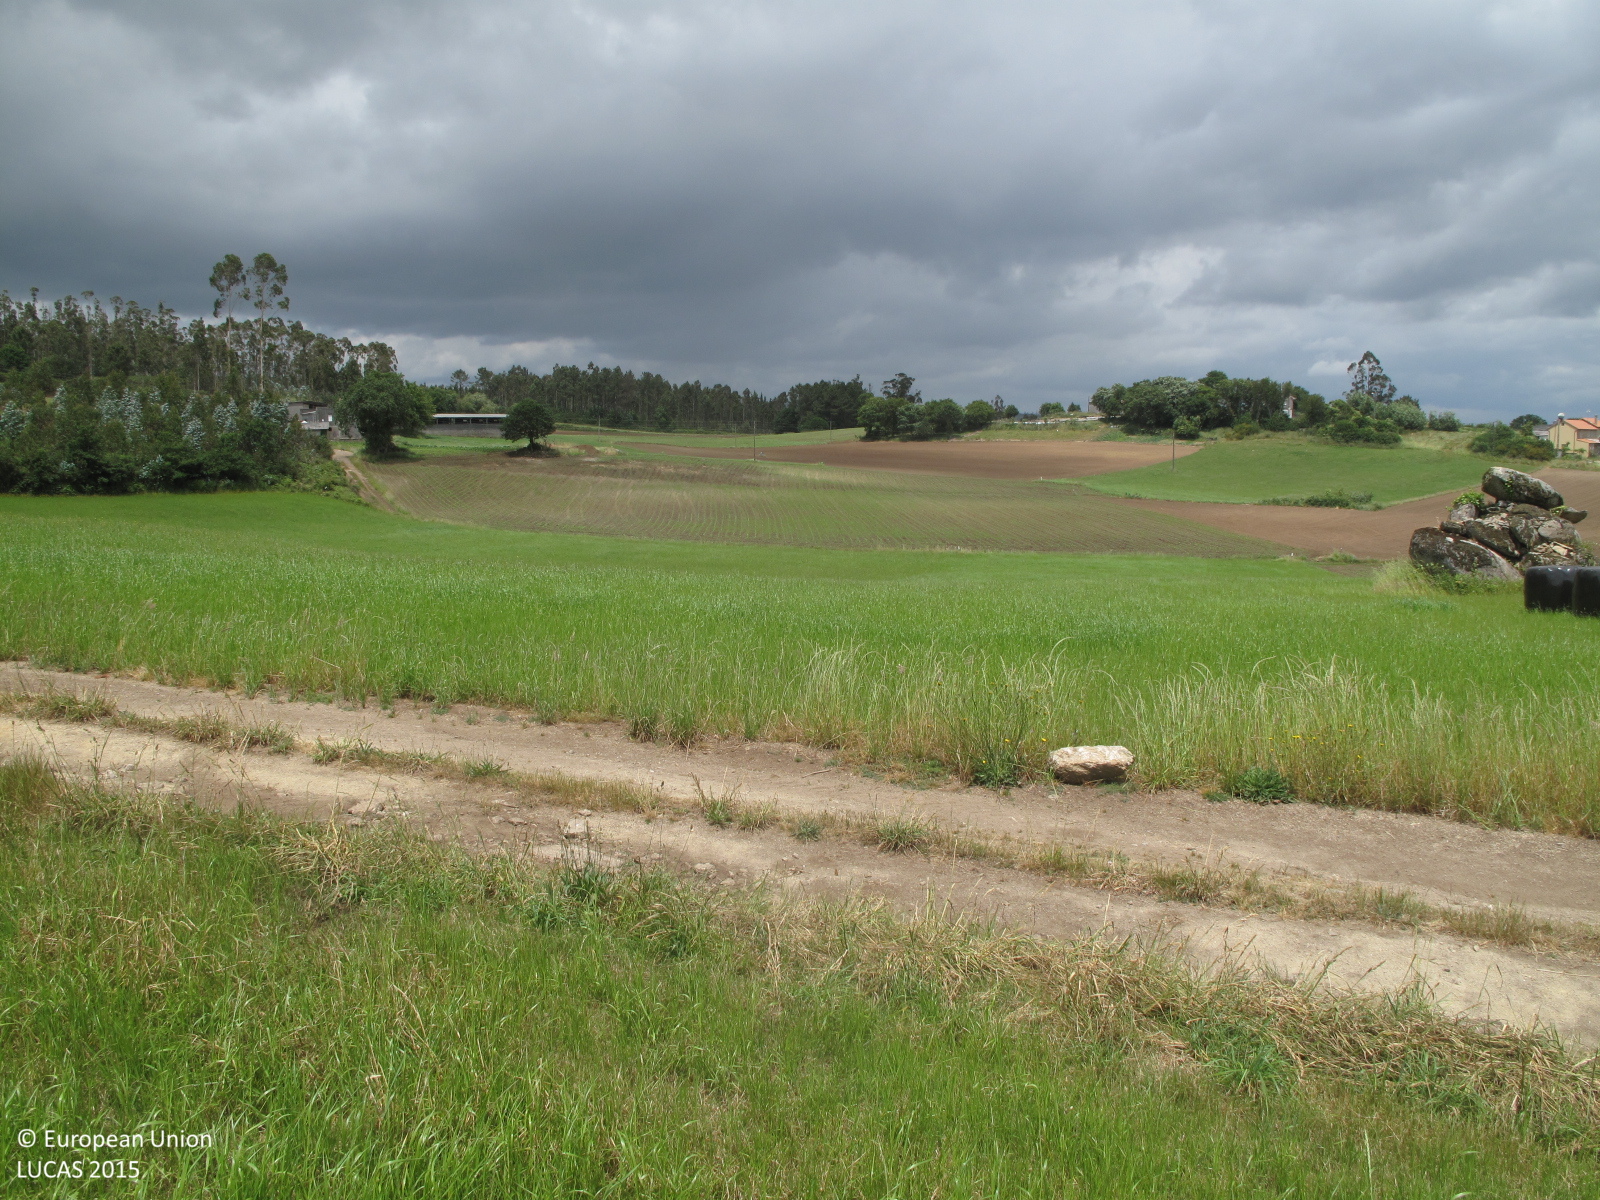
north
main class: Grassland
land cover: Grassland without tree/shrub cover
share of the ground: > 75 %
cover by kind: herbaceous plants 100 %
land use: Agriculture (excluding fallow land and kitchen gardens)
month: June
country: ES
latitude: 43.1073
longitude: -8.5272
